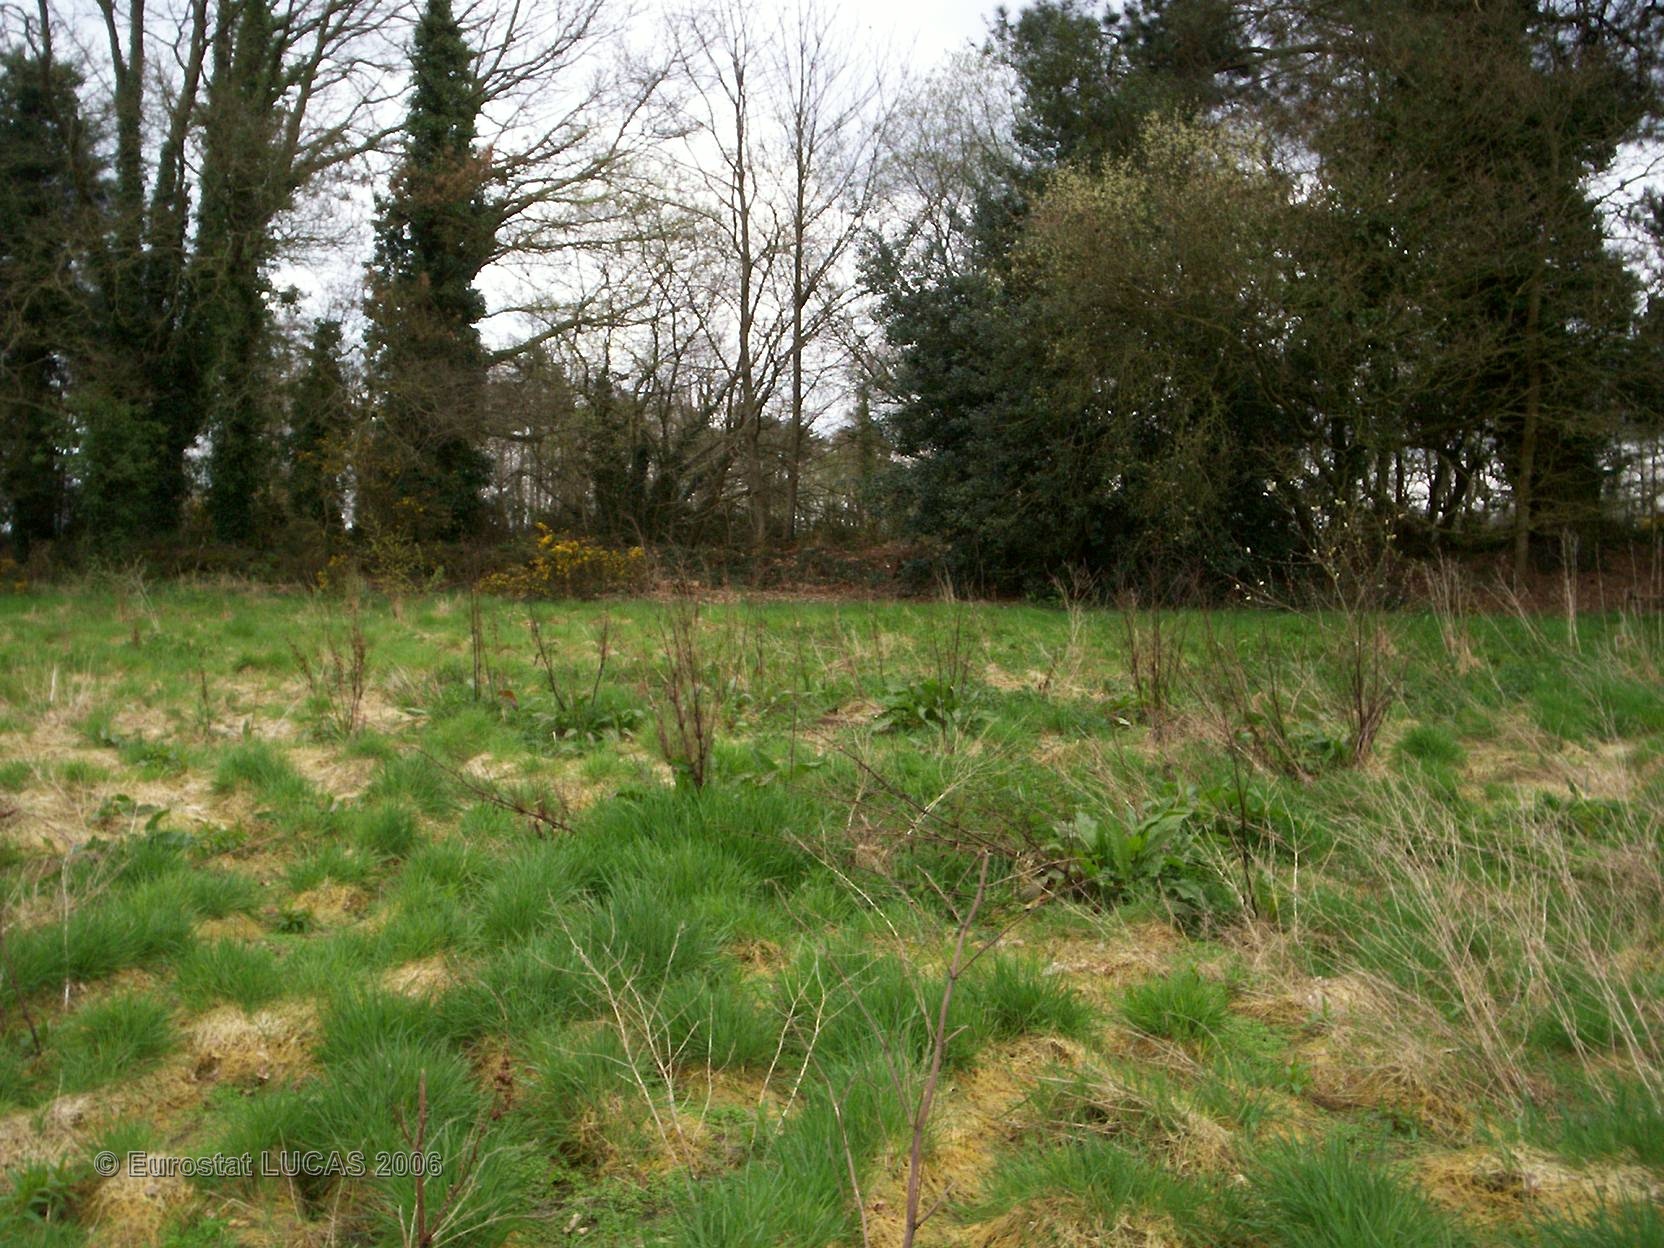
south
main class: Grassland
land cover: Grassland without tree/shrub cover
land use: Fallow land
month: April
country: FR
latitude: 48.1360
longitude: -2.8999
